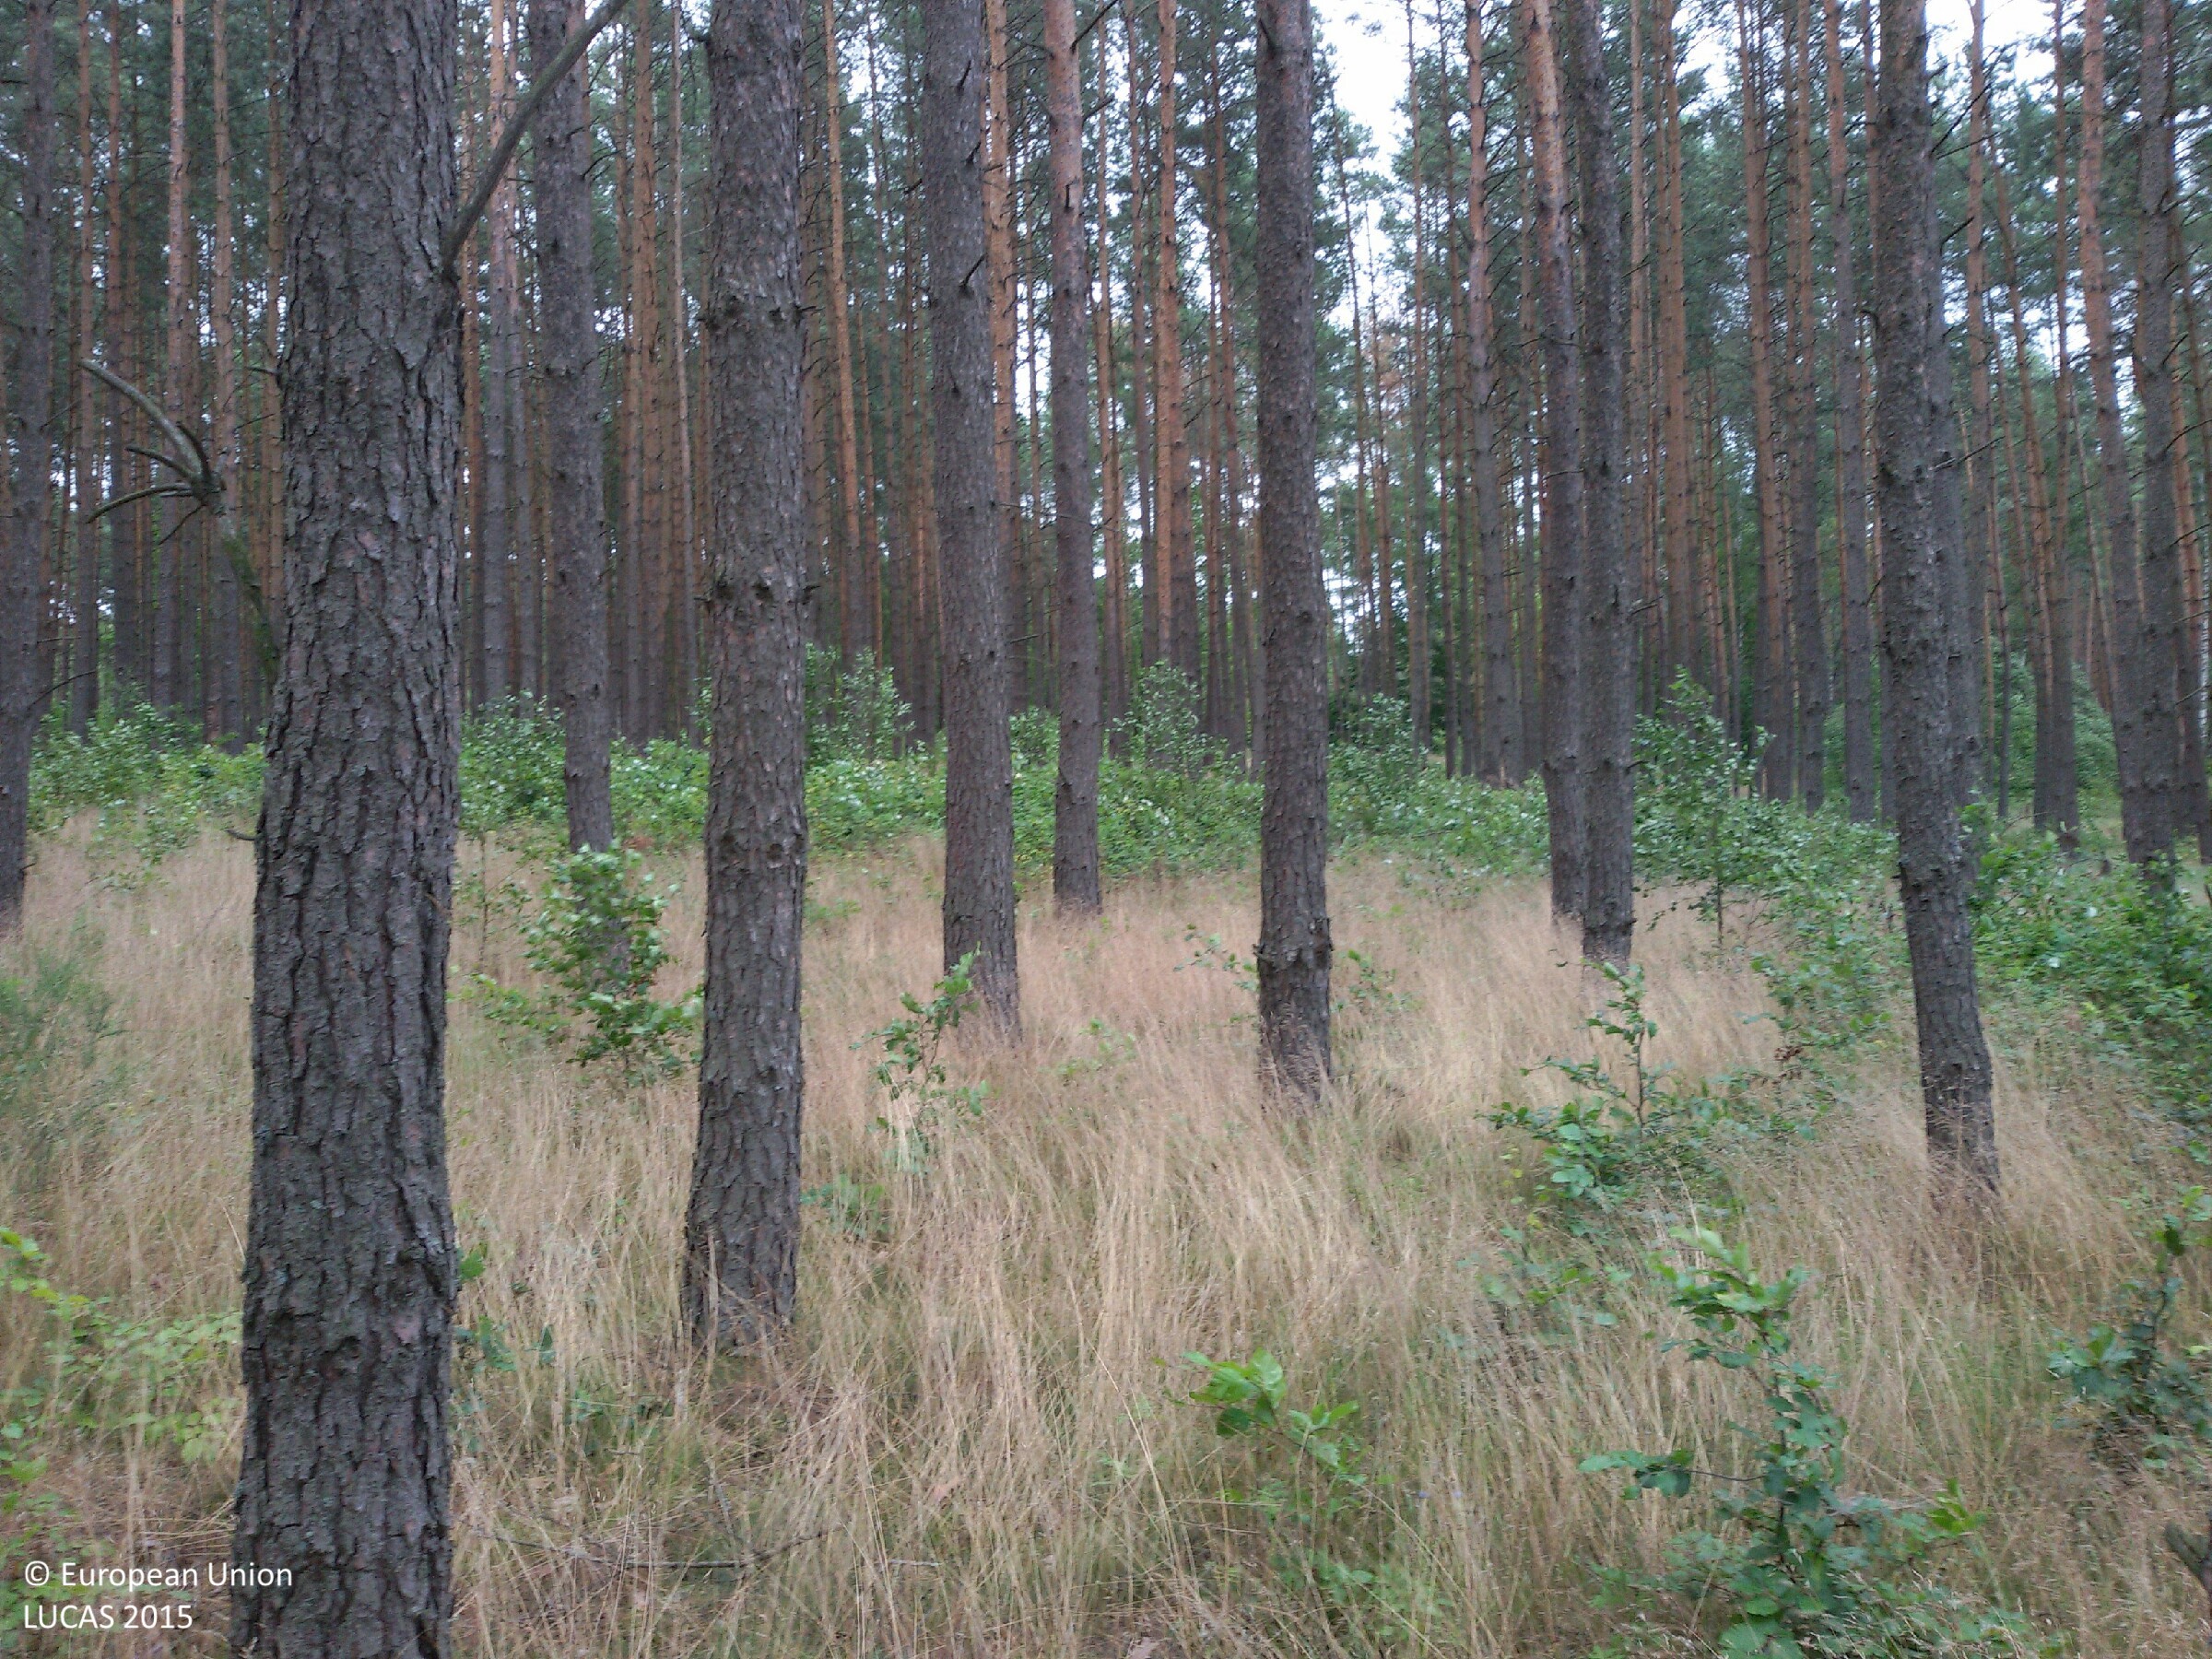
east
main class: Woodland
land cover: Pine dominated coniferous woodland
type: hemiboreal forest and nemoral coniferous forest and mixed broadleaved-coniferous forest
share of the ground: > 75 %
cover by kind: coniferous forest trees 85 %, herbaceous plants 10 %, broadleaved forest trees 5 %
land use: Forestry
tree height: > 5 m
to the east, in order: Pine dominated coniferous woodland; Tracks; Pine dominated mixed woodland; Other mixed woodland
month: July
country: PL
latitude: 53.1493
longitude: 16.2711
